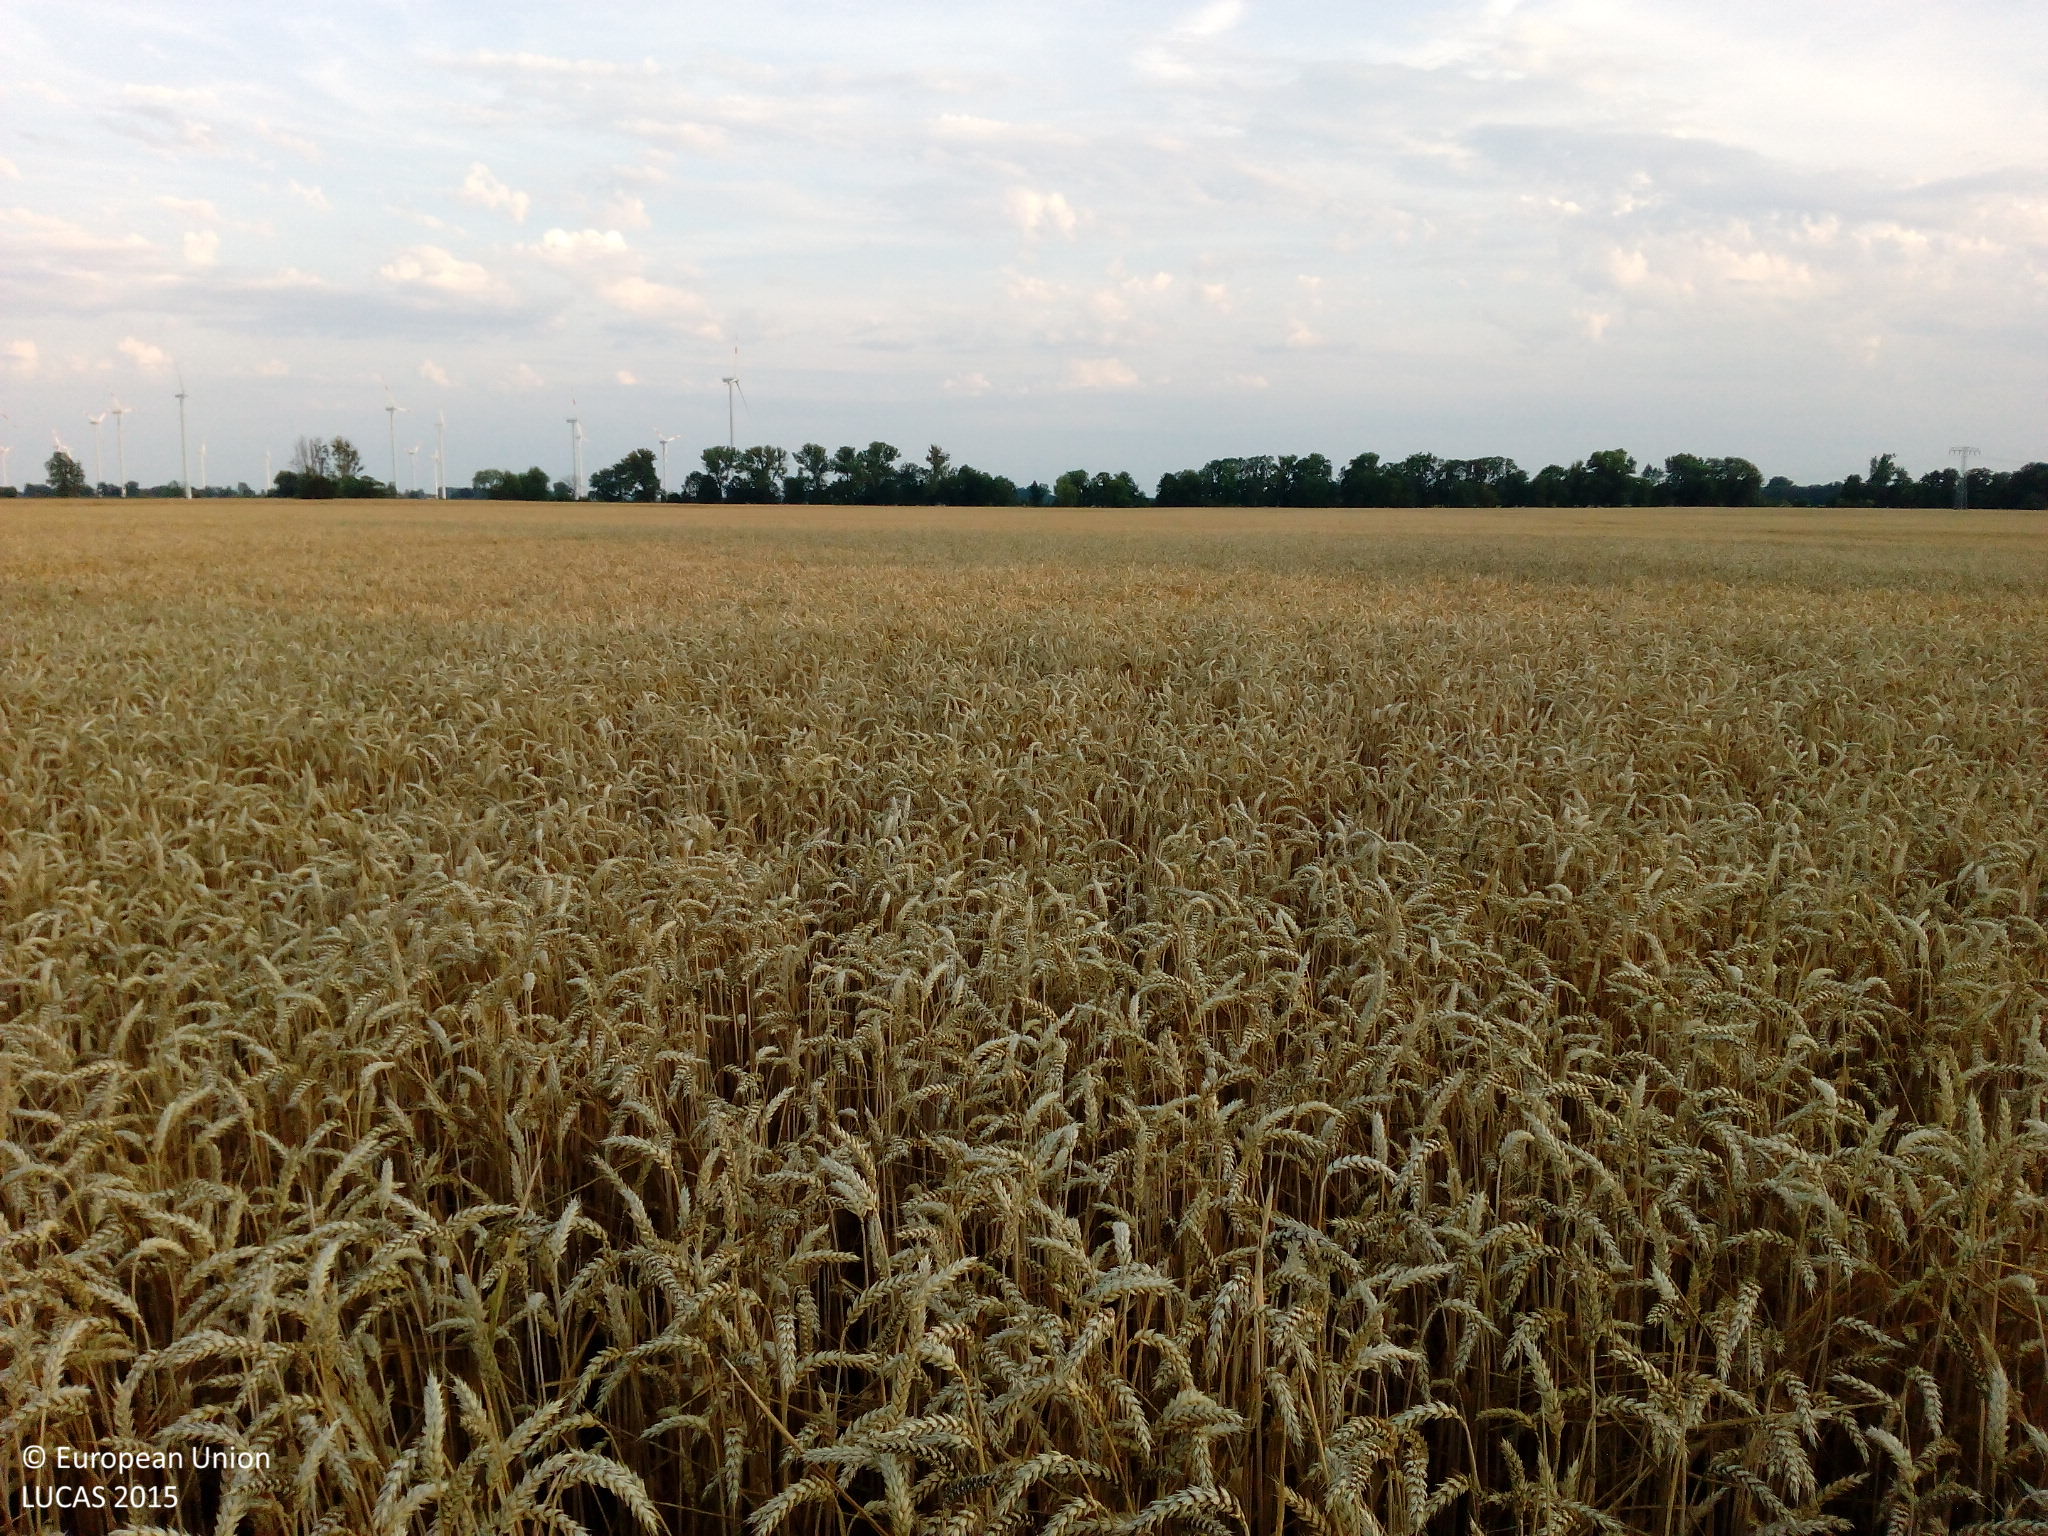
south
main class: Cropland
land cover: Common wheat
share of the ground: > 75 %
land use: Agriculture (excluding fallow land and kitchen gardens)
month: July
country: DE
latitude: 52.7186
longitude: 14.1610
